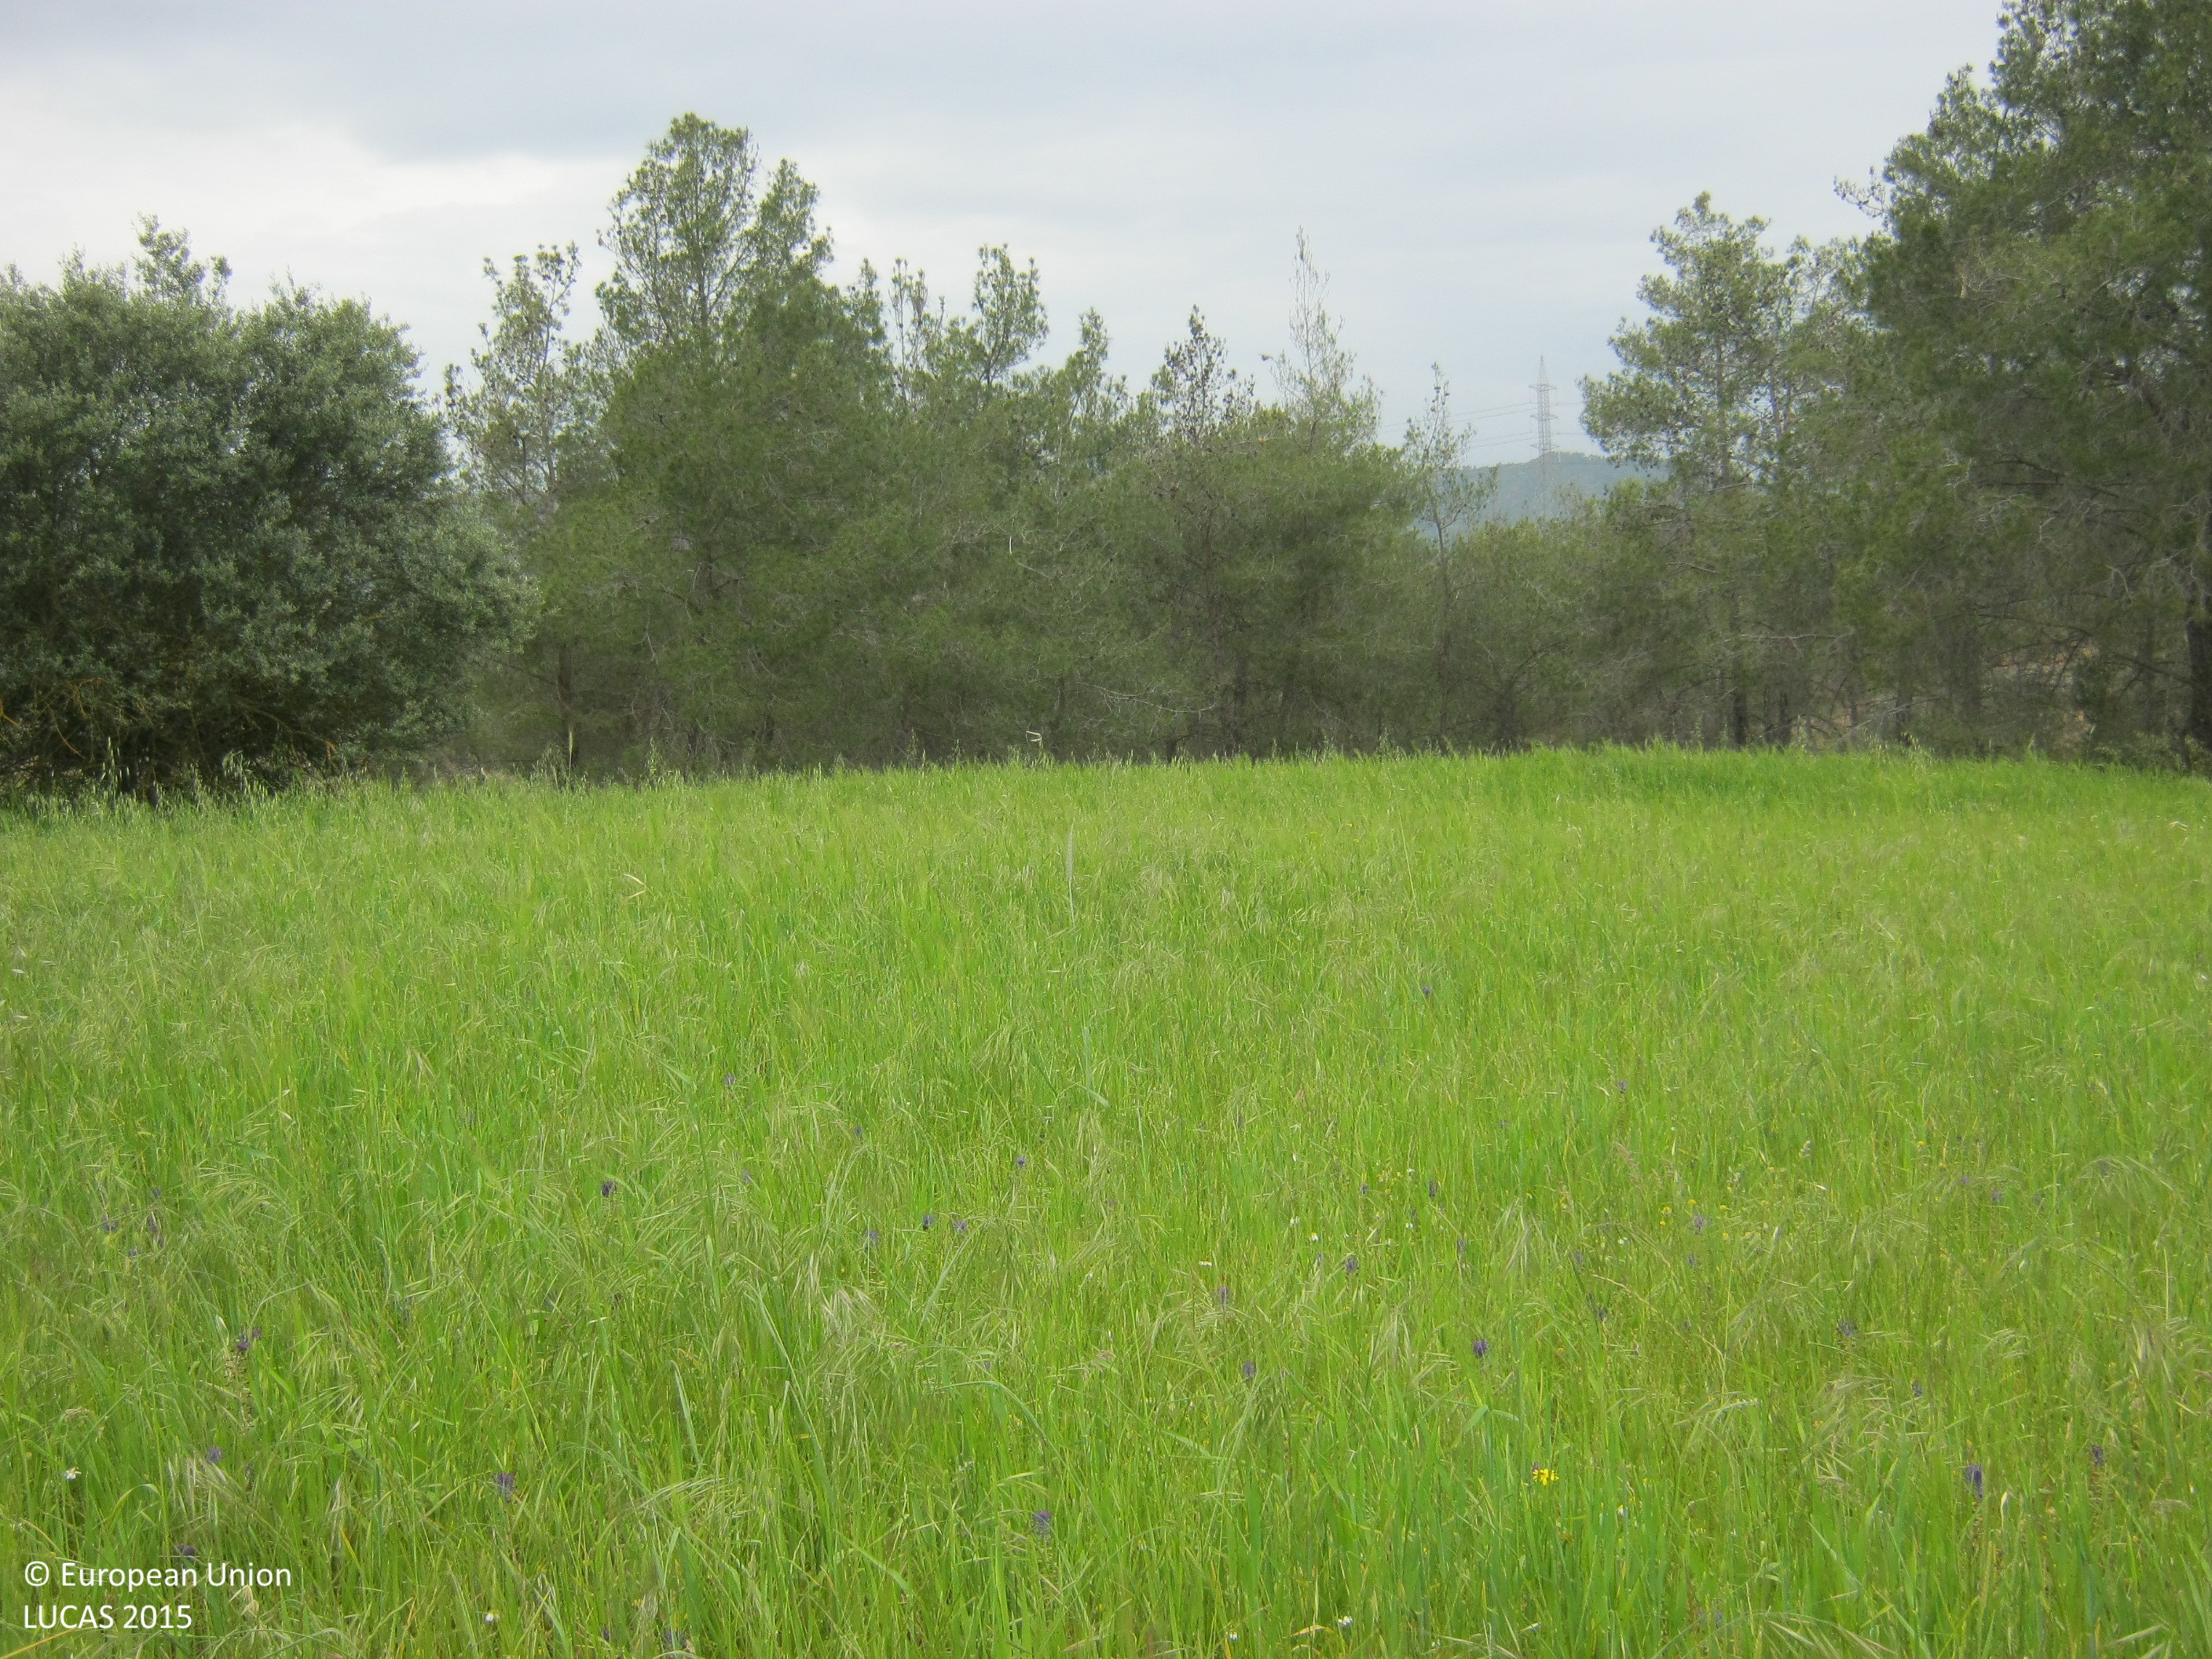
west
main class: Cropland
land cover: Common wheat
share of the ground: > 75 %
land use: Agriculture (excluding fallow land and kitchen gardens)
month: April
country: CY
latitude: 34.9263
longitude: 33.3604
